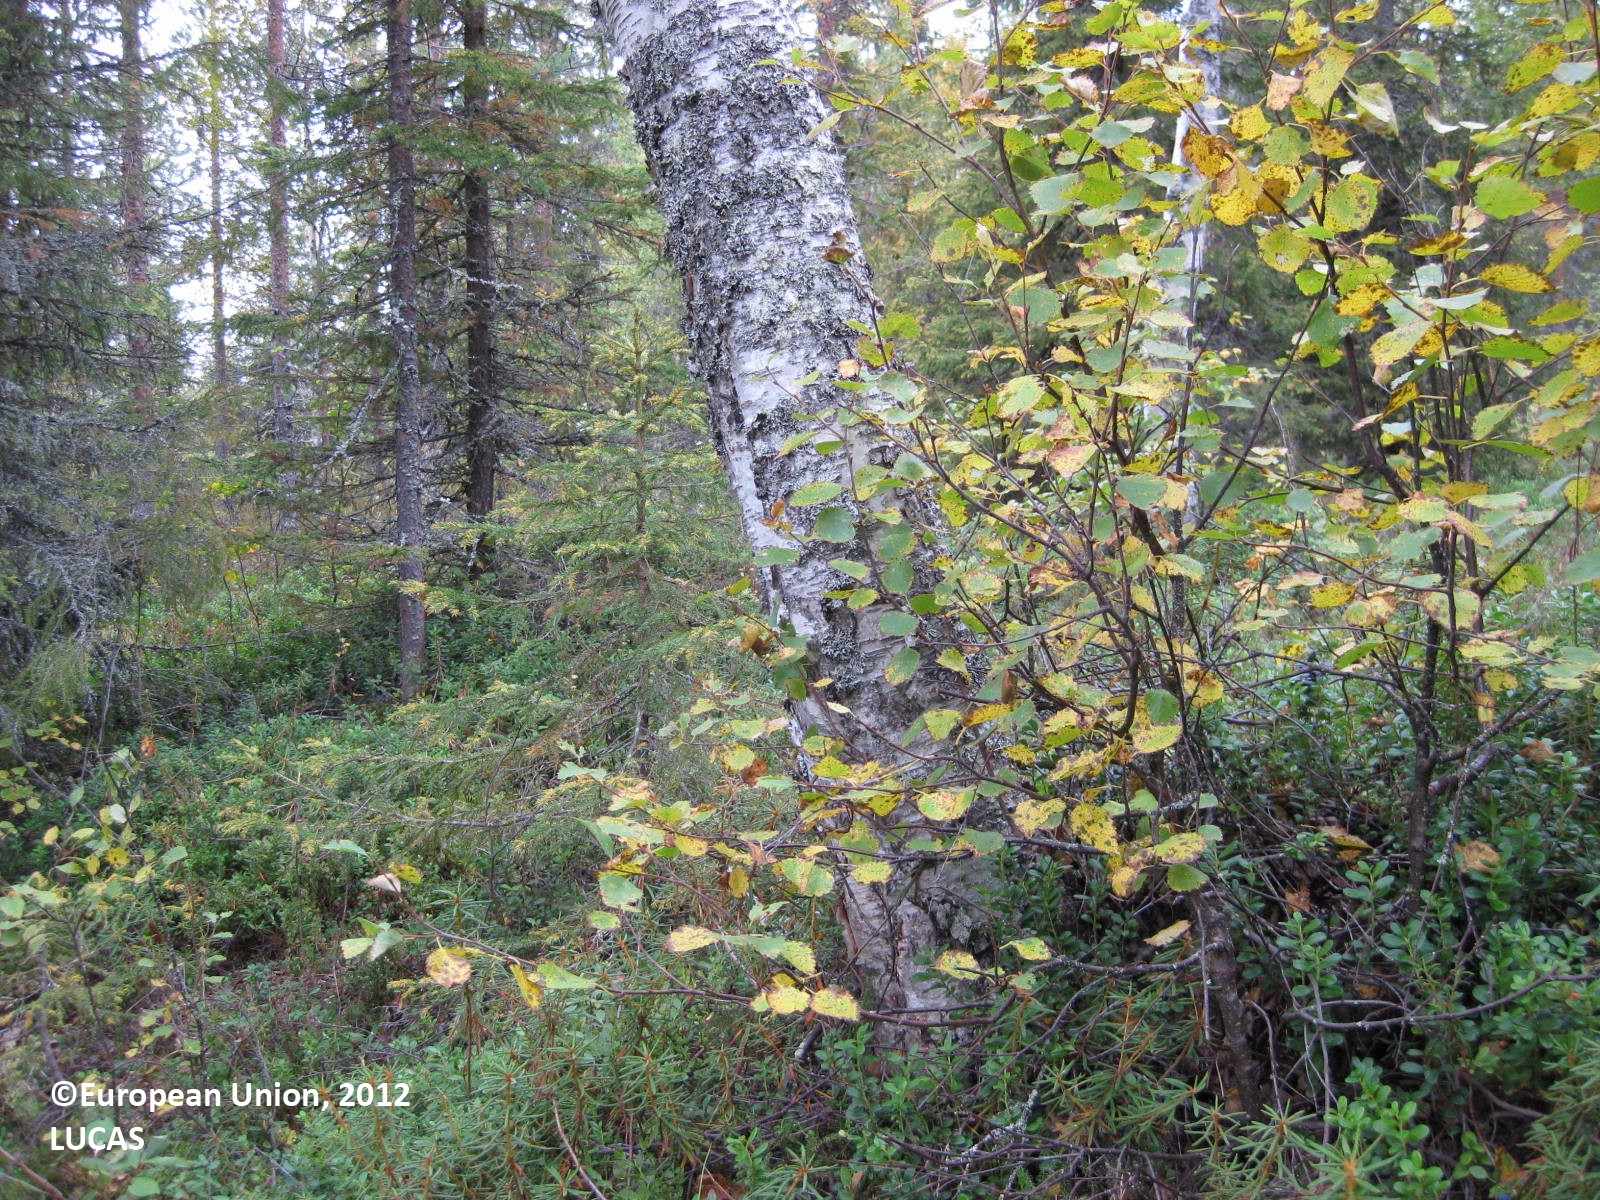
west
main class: Woodland
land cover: Other mixed woodland
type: boreal forest
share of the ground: 50 - 75 %
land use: Forestry
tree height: > 5 m
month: August
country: FI
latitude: 65.9650
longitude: 29.8079
